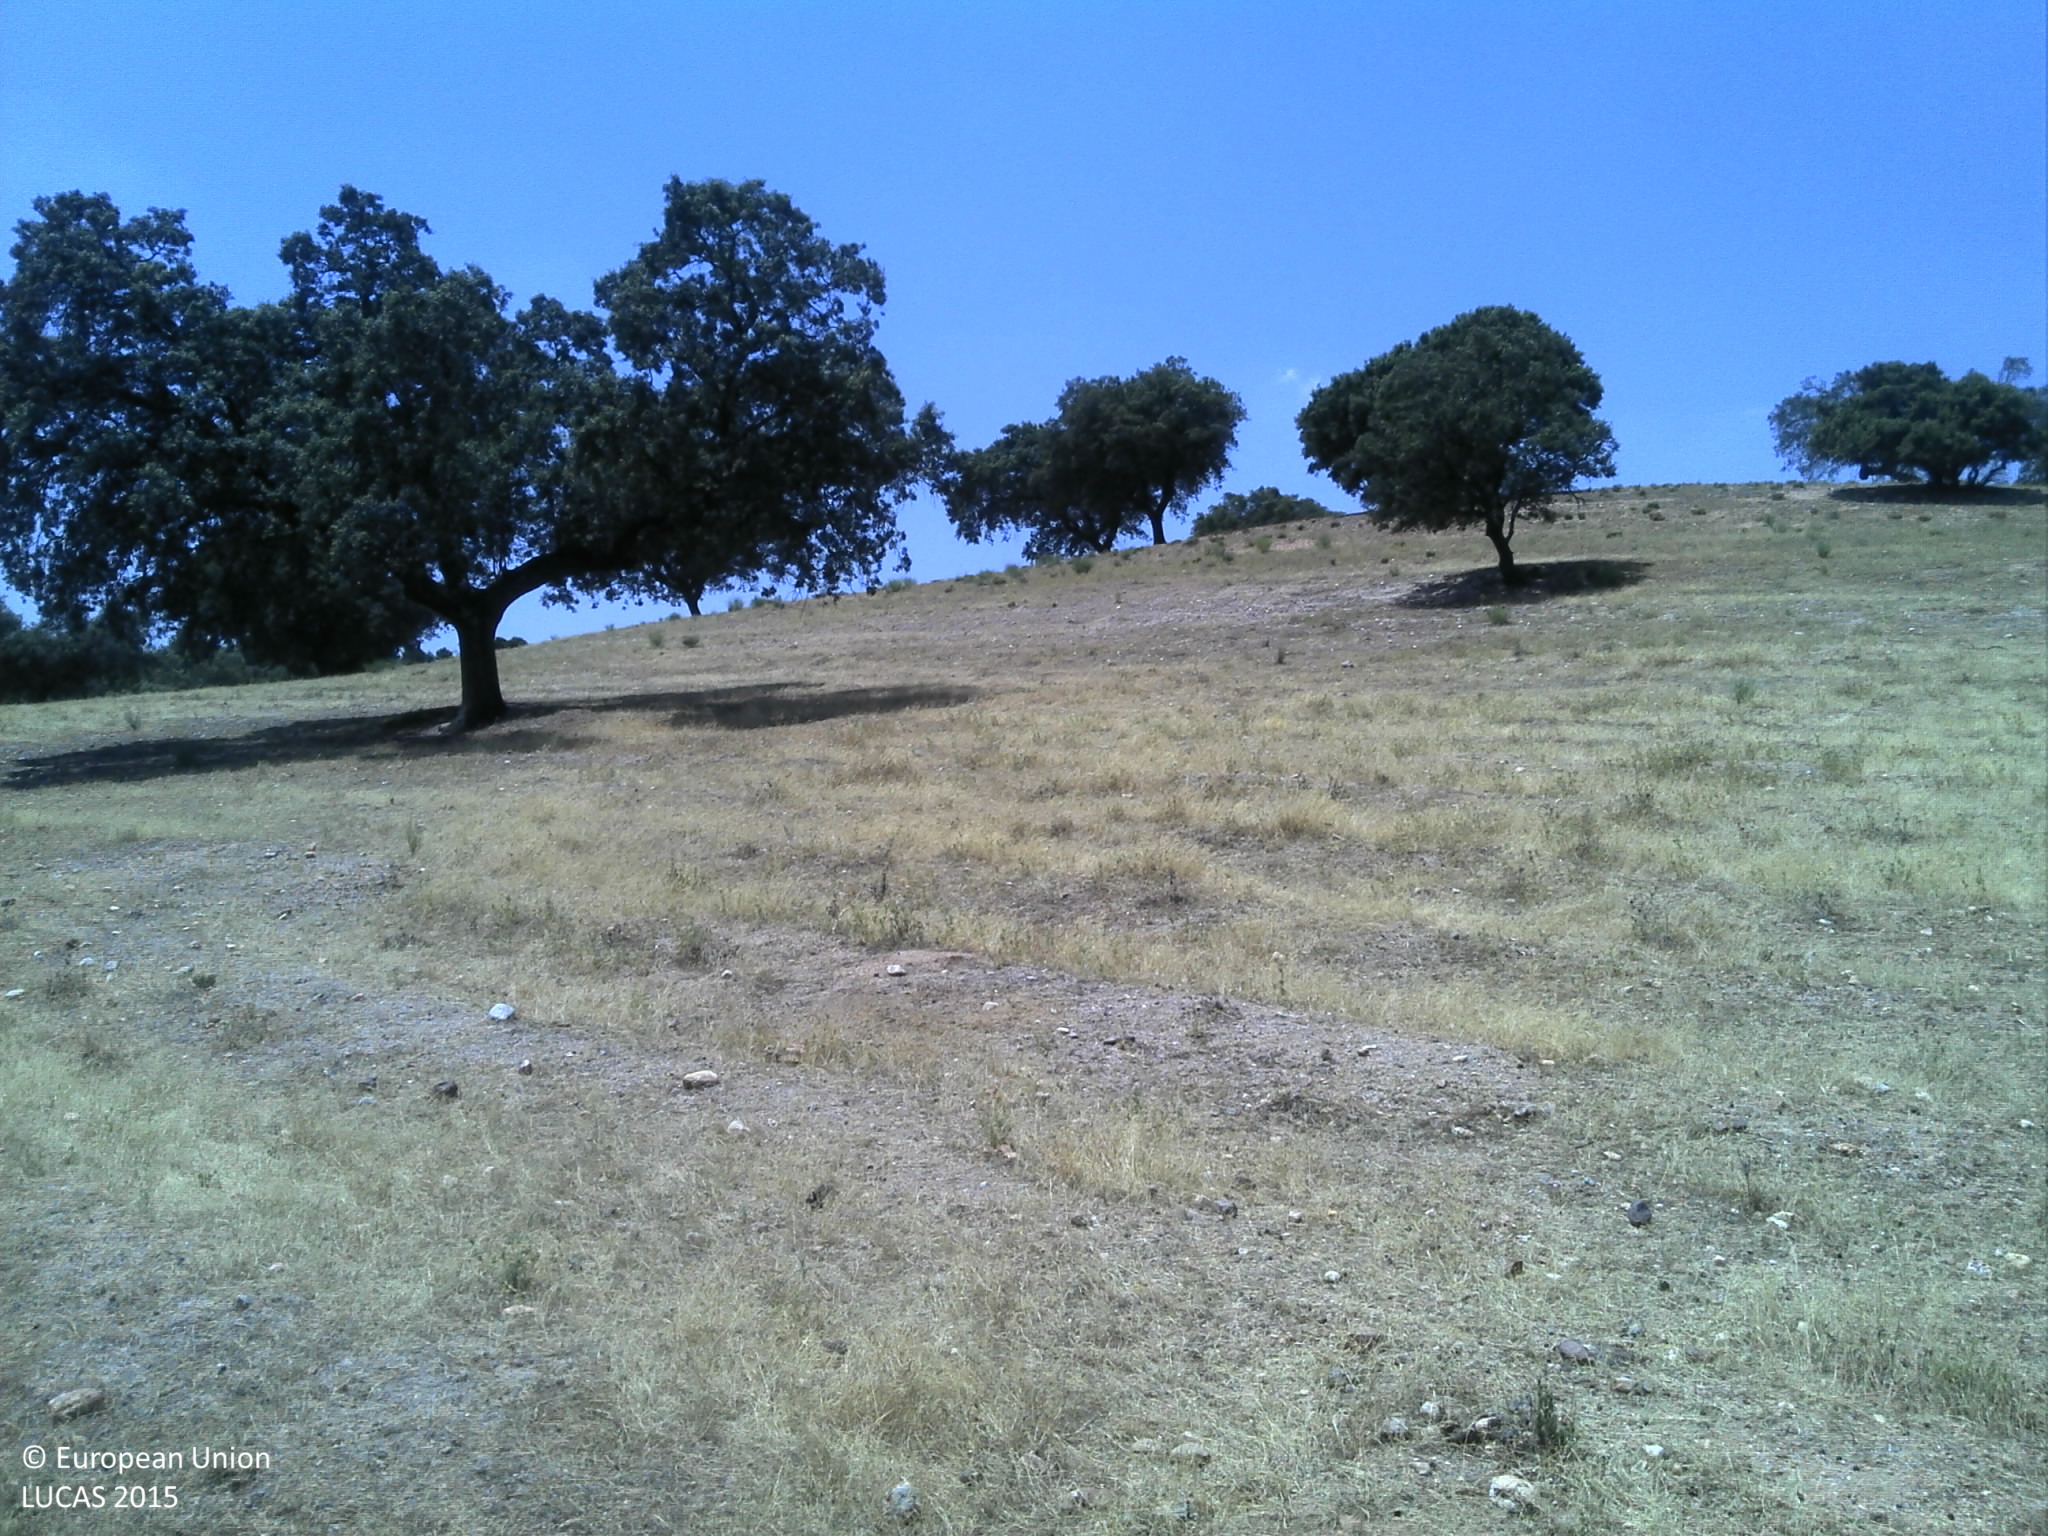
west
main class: Grassland
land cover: Grassland without tree/shrub cover
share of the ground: 25 - 50 %
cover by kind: herbaceous plants 45 %, unconsolidated bare surface 45 %, shrubs 5 %
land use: Agriculture (excluding fallow land and kitchen gardens)
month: June
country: PT
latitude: 39.7602
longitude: -7.1432
